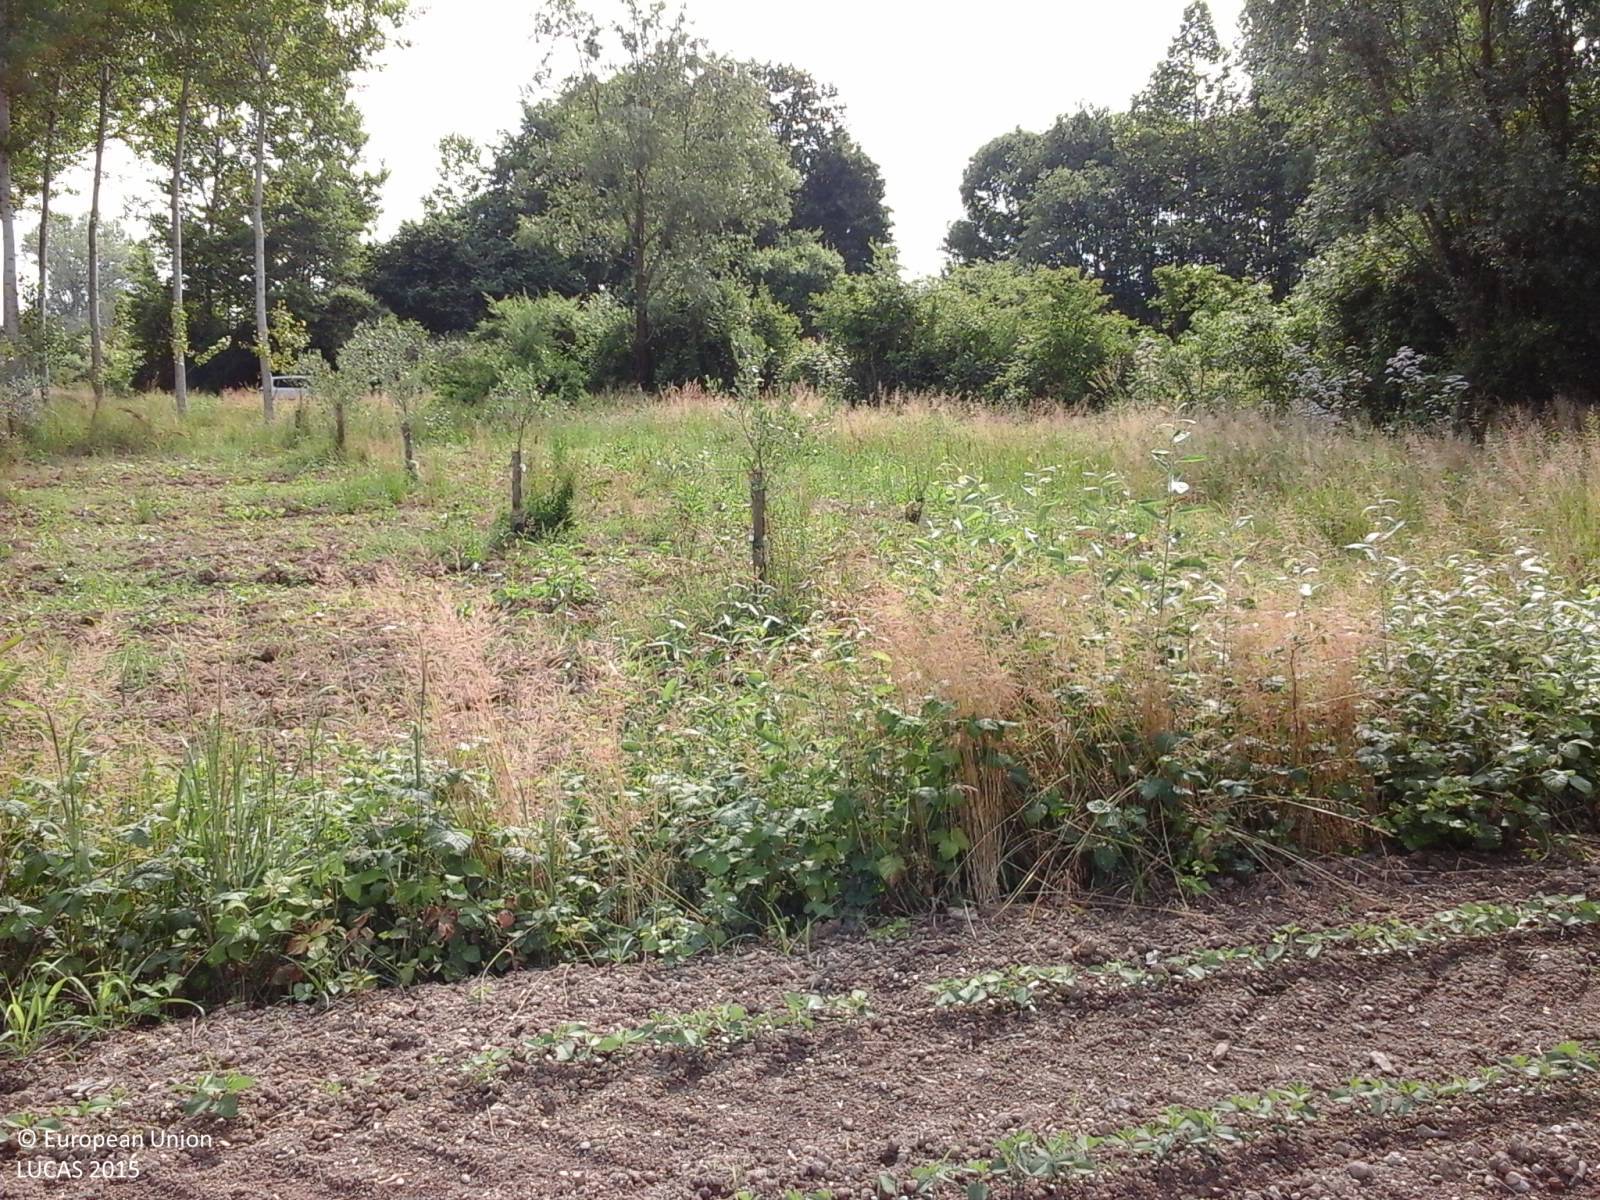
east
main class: Cropland
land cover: Soya
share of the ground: < 10 %
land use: Agriculture (excluding fallow land and kitchen gardens)
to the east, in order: Soya; Ditches and canals; Olive groves; Grass margins; Ditches and canals; Grass margins; Tracks; Grass margins; Ditches and canals; Abandoned hedges; Grassland without tree/shrub cover; Ditches and canals; Grass margins; Tracks; Grass margins; Broadleaved woodland; Ditches and canals; Tracks; Maize; Ditches and canals; Managed hedges; Soya
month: May
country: IT
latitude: 45.8526
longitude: 13.2028
